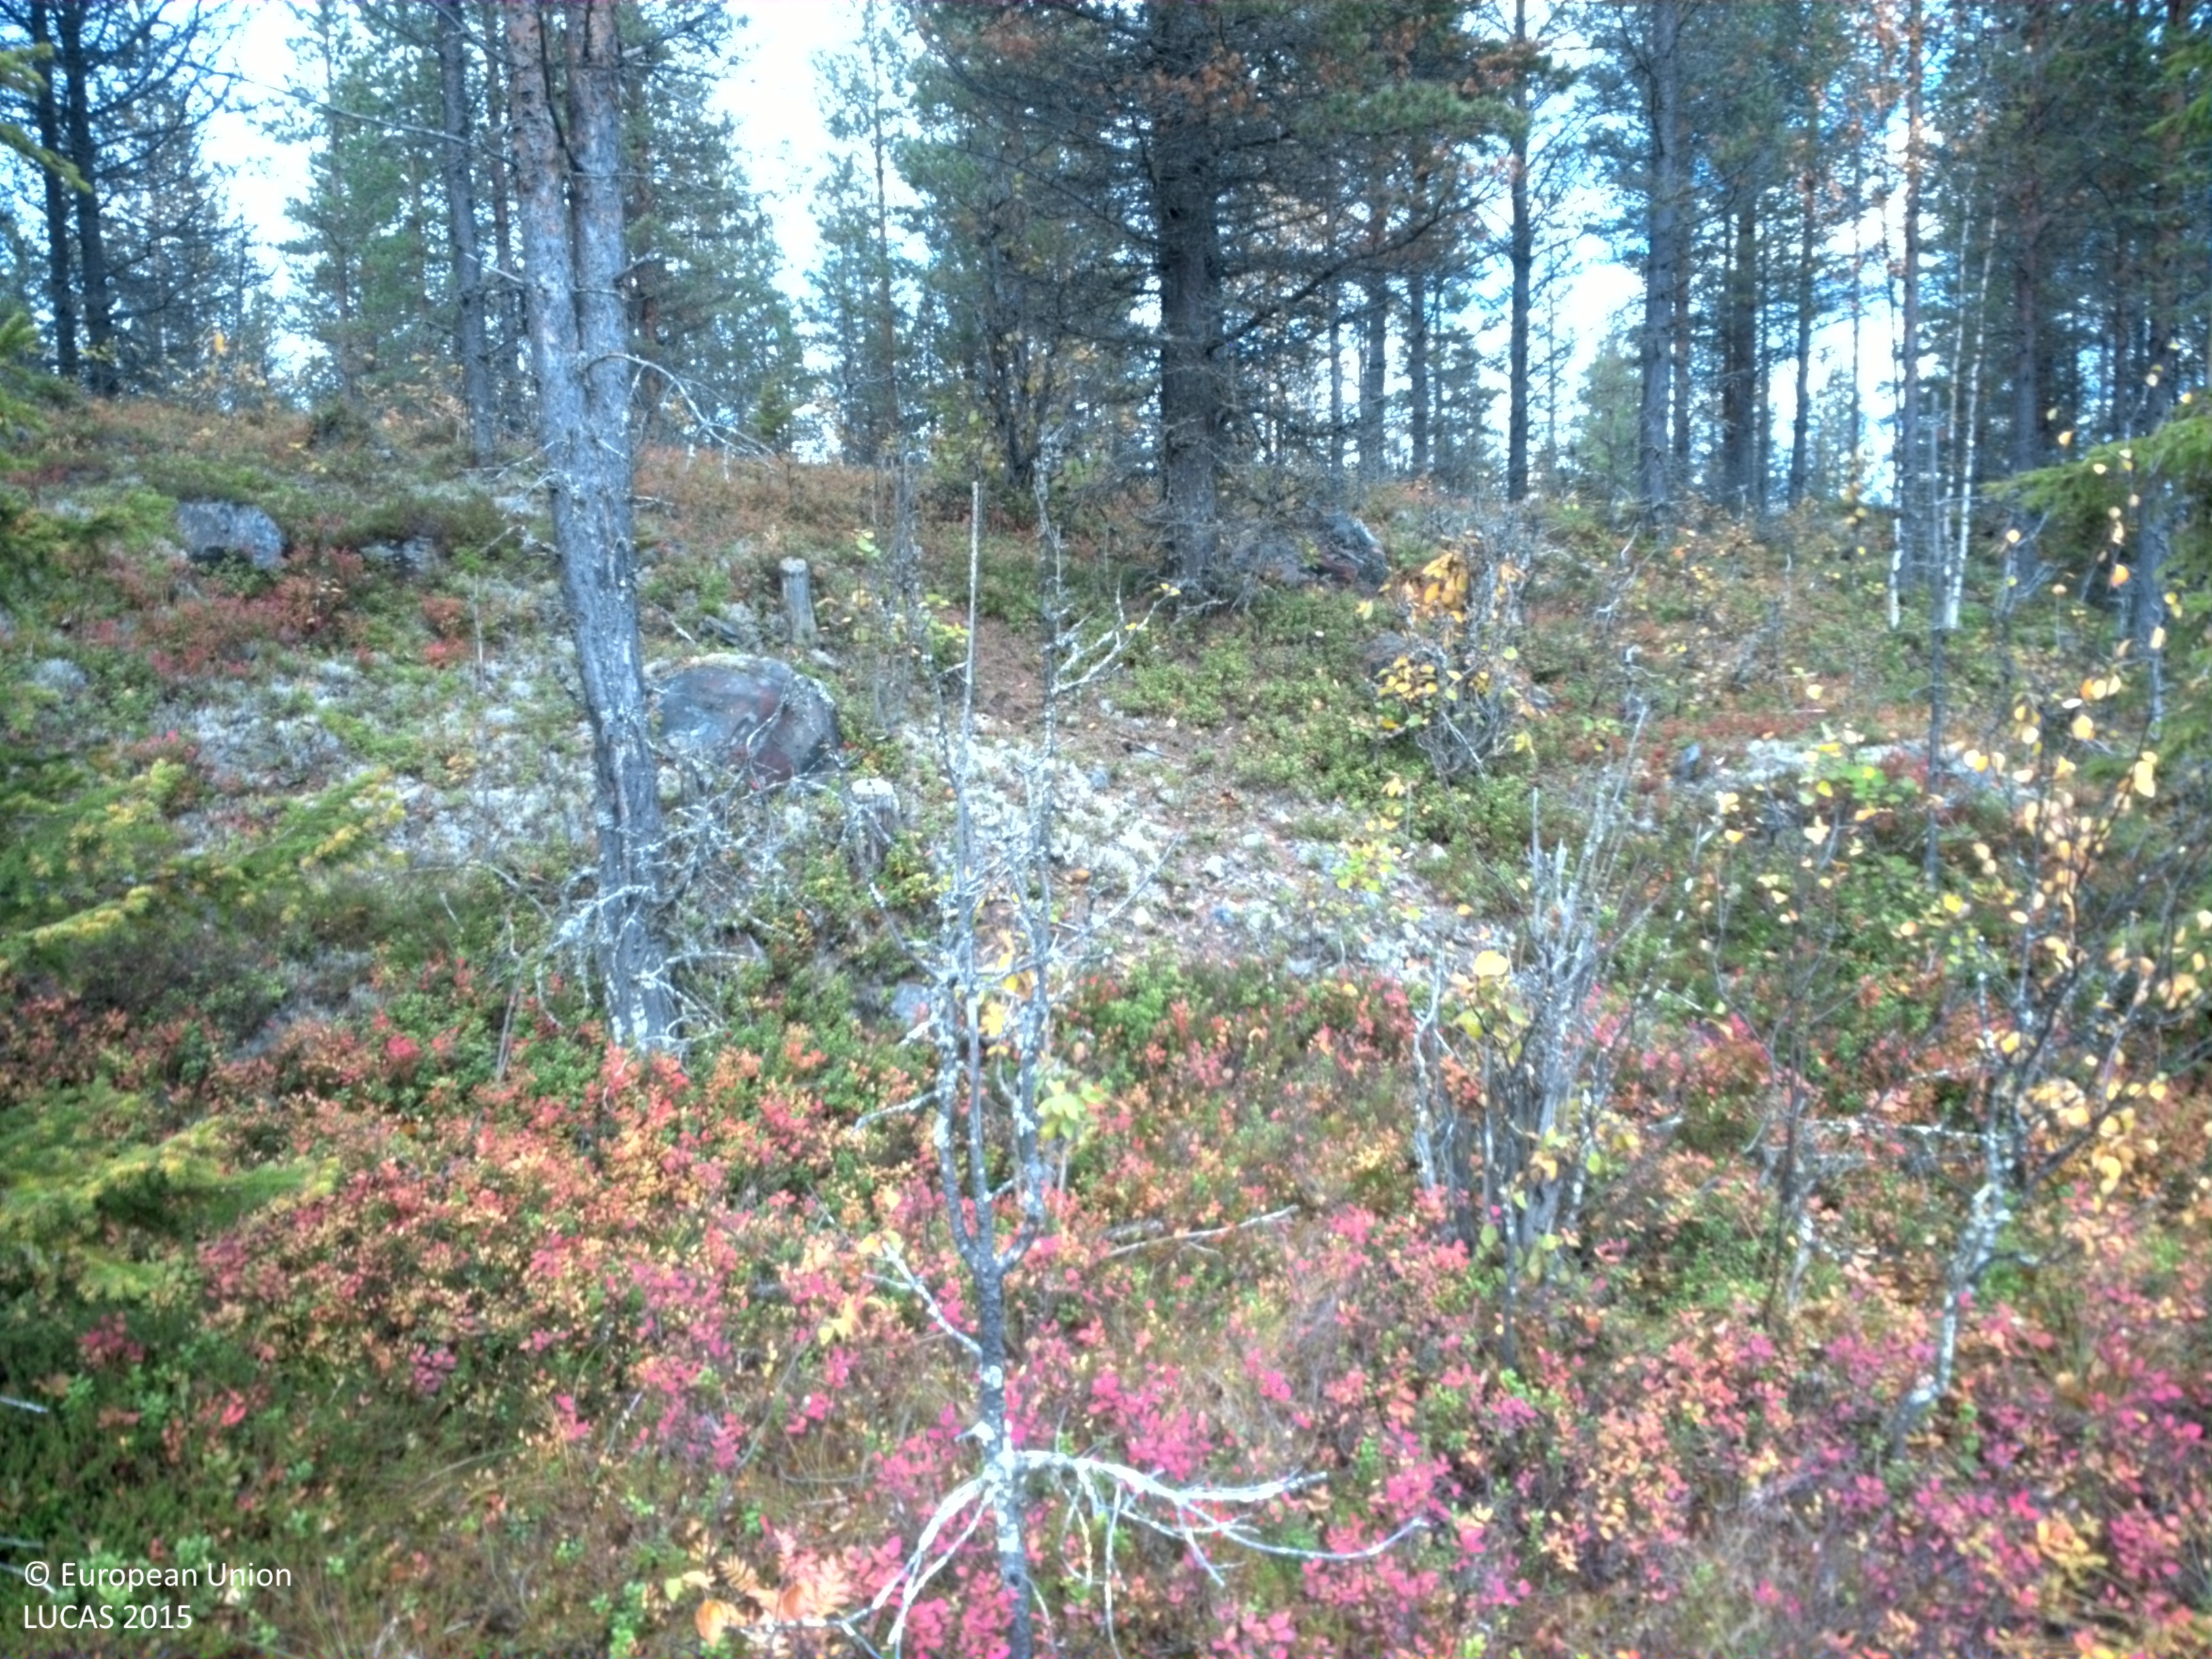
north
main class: Shrubland
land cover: Shrubland with sparse tree cover
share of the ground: 50 - 75 %
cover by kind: shrubs 70 %, lichens and mosses 15 %, herbaceous plants 10 %, broadleaved forest trees 5 %
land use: Semi-natural and natural areas not in use
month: September
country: SE
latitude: 64.8446
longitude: 17.7448
